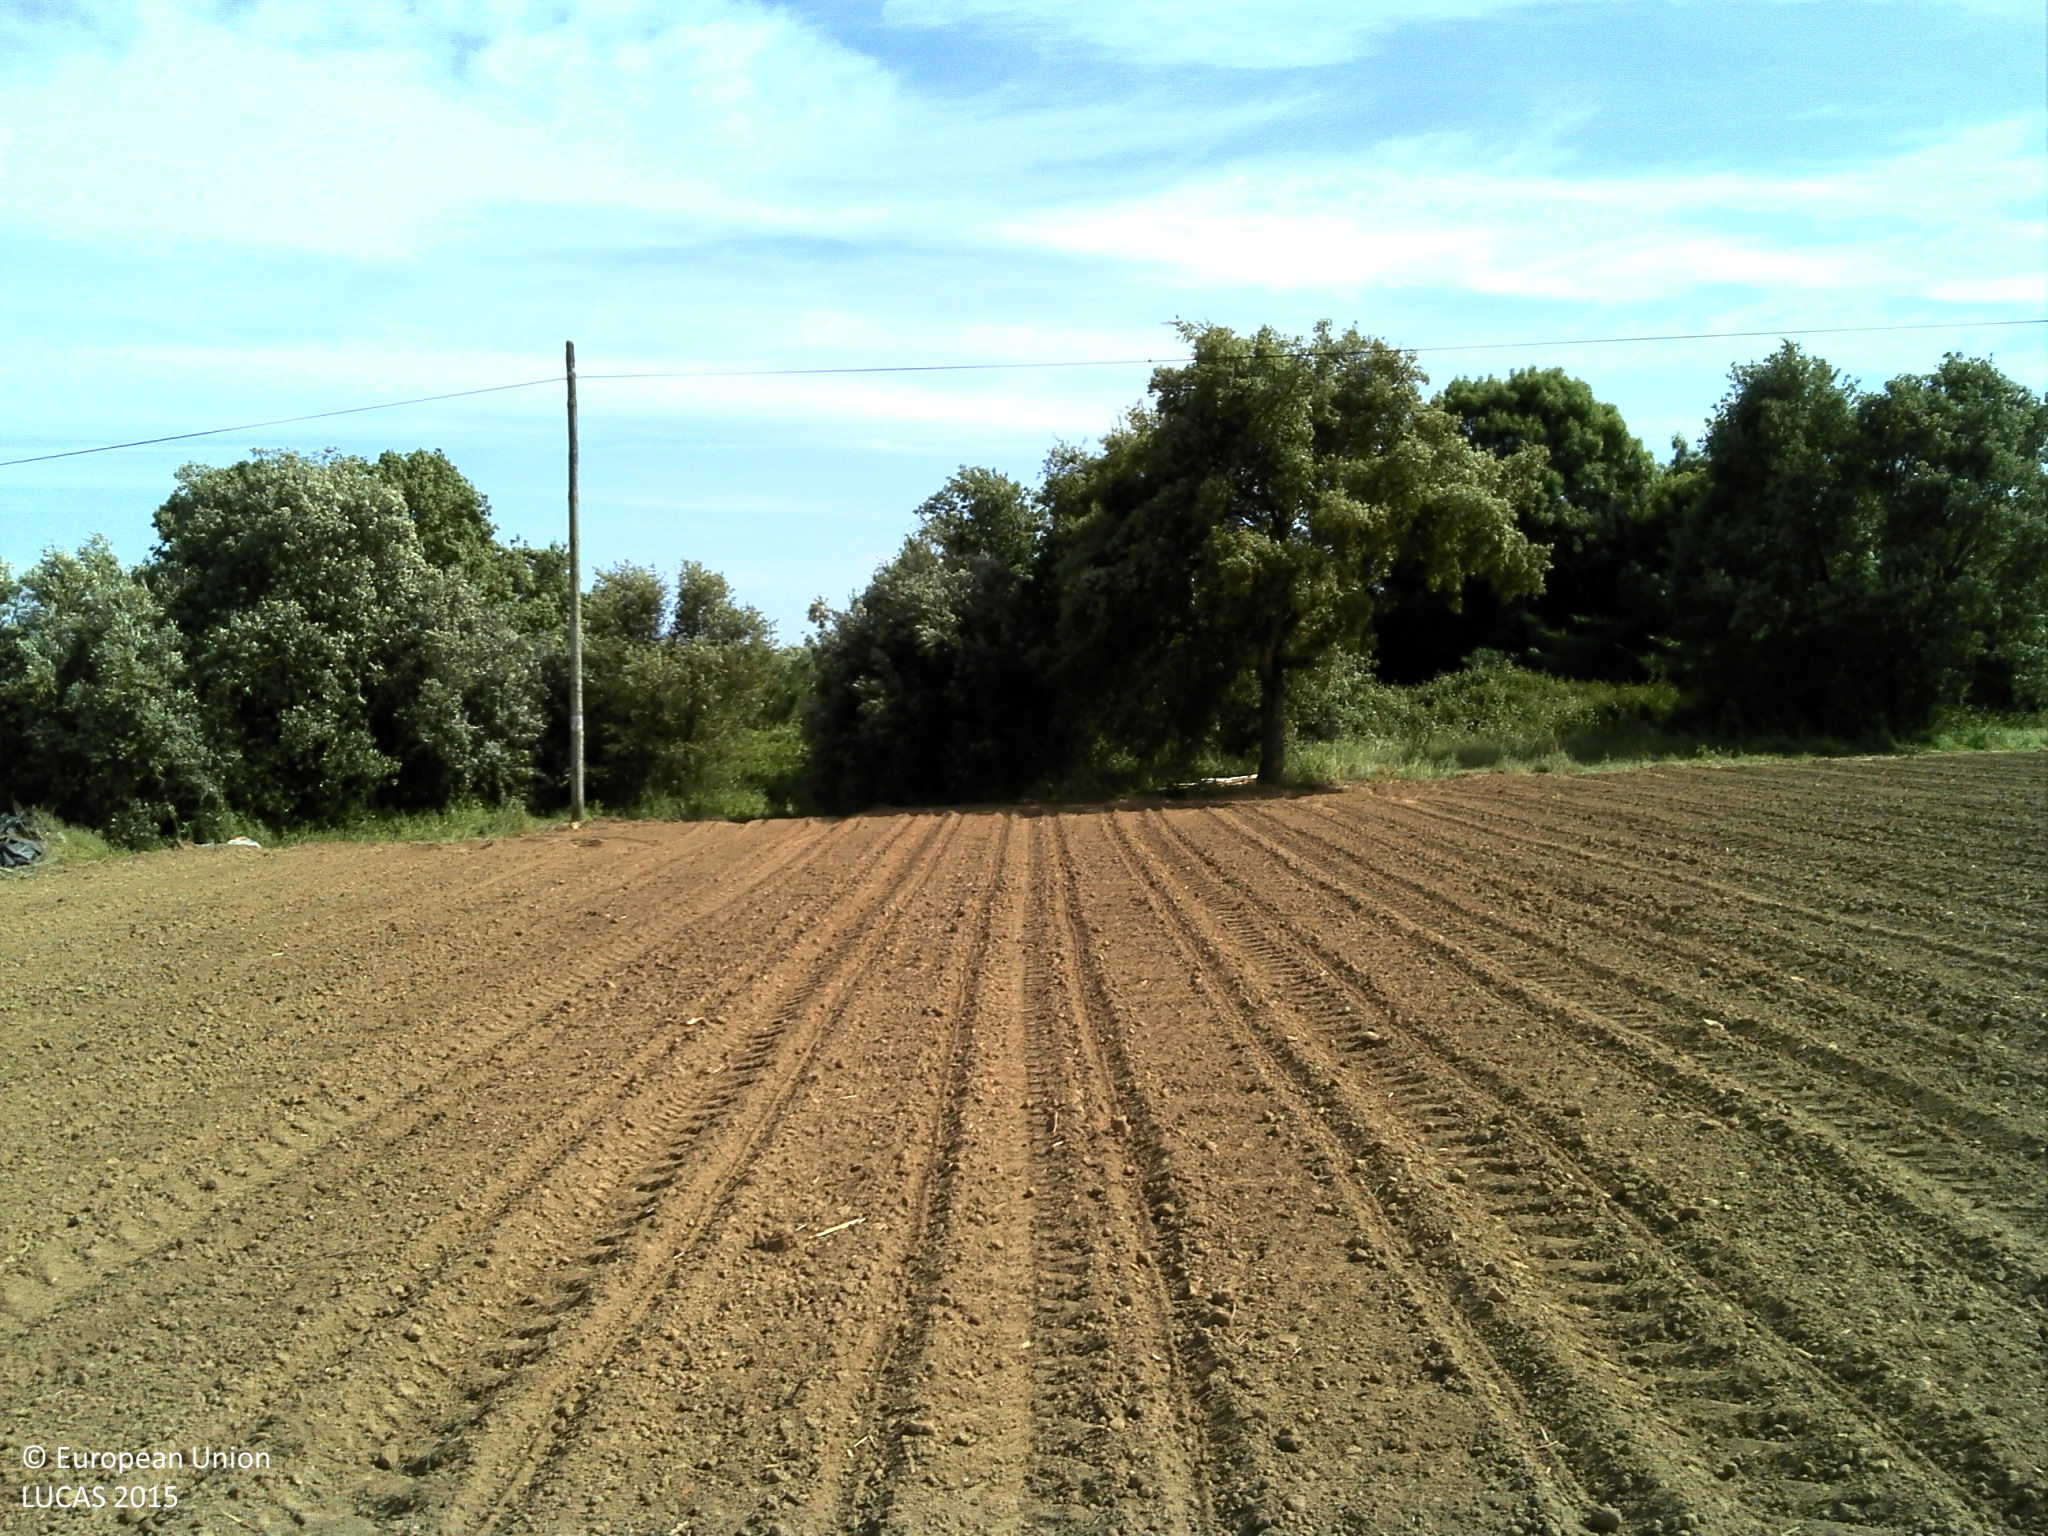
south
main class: Cropland
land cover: Maize
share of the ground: < 10 %
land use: Agriculture (excluding fallow land and kitchen gardens)
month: May
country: PT
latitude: 39.5900
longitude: -8.3632
